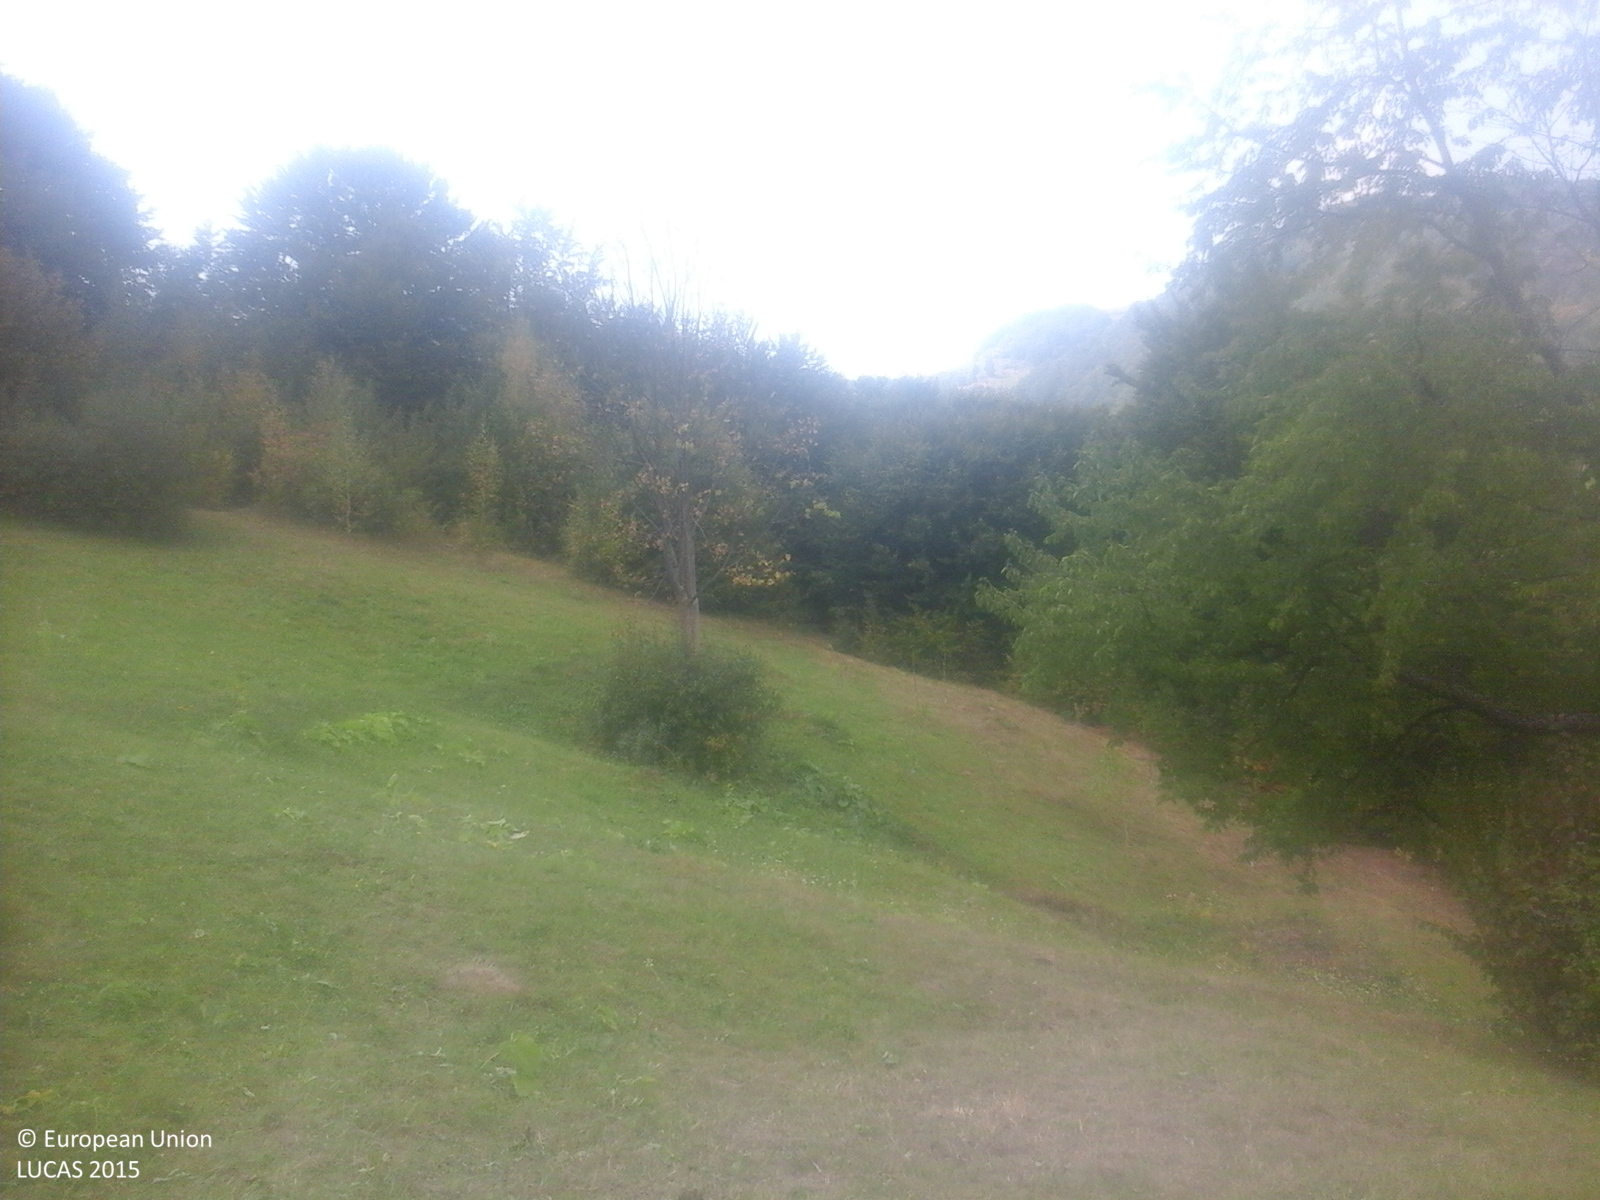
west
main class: Grassland
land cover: Grassland without tree/shrub cover
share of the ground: > 75 %
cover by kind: herbaceous plants 100 %
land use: Agriculture (excluding fallow land and kitchen gardens)
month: September
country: RO
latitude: 47.6267
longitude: 24.3429
